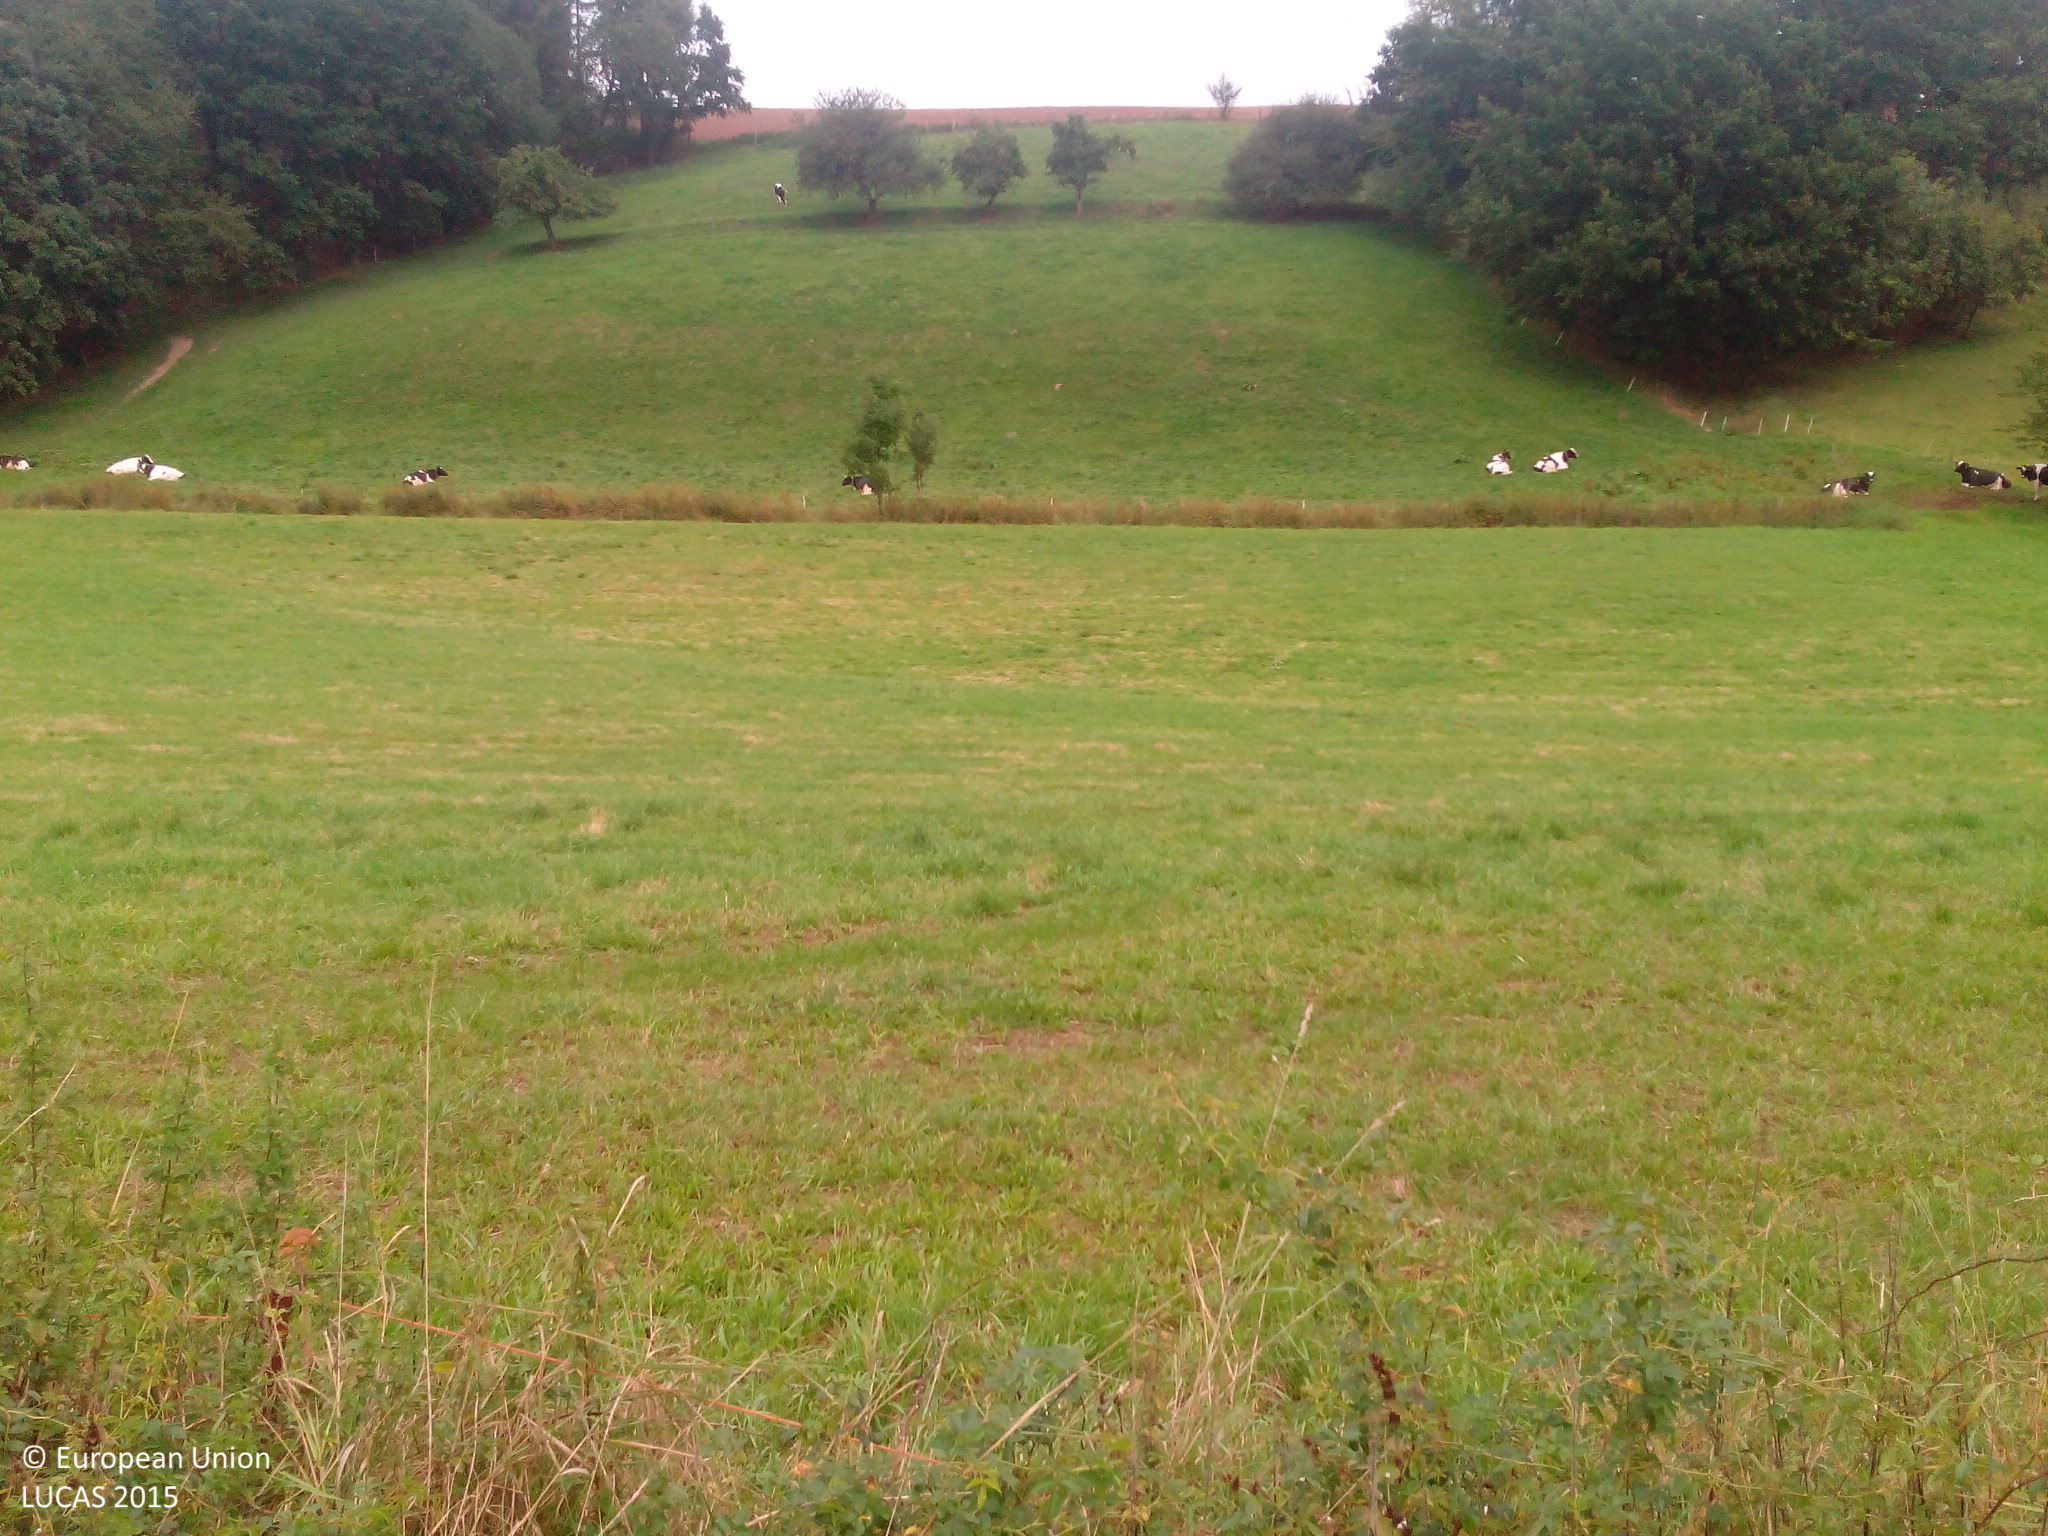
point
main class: Grassland
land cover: Grassland without tree/shrub cover
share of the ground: > 75 %
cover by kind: herbaceous plants 100 %
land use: Agriculture (excluding fallow land and kitchen gardens)
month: September
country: DE
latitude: 51.5490
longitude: 10.6199
